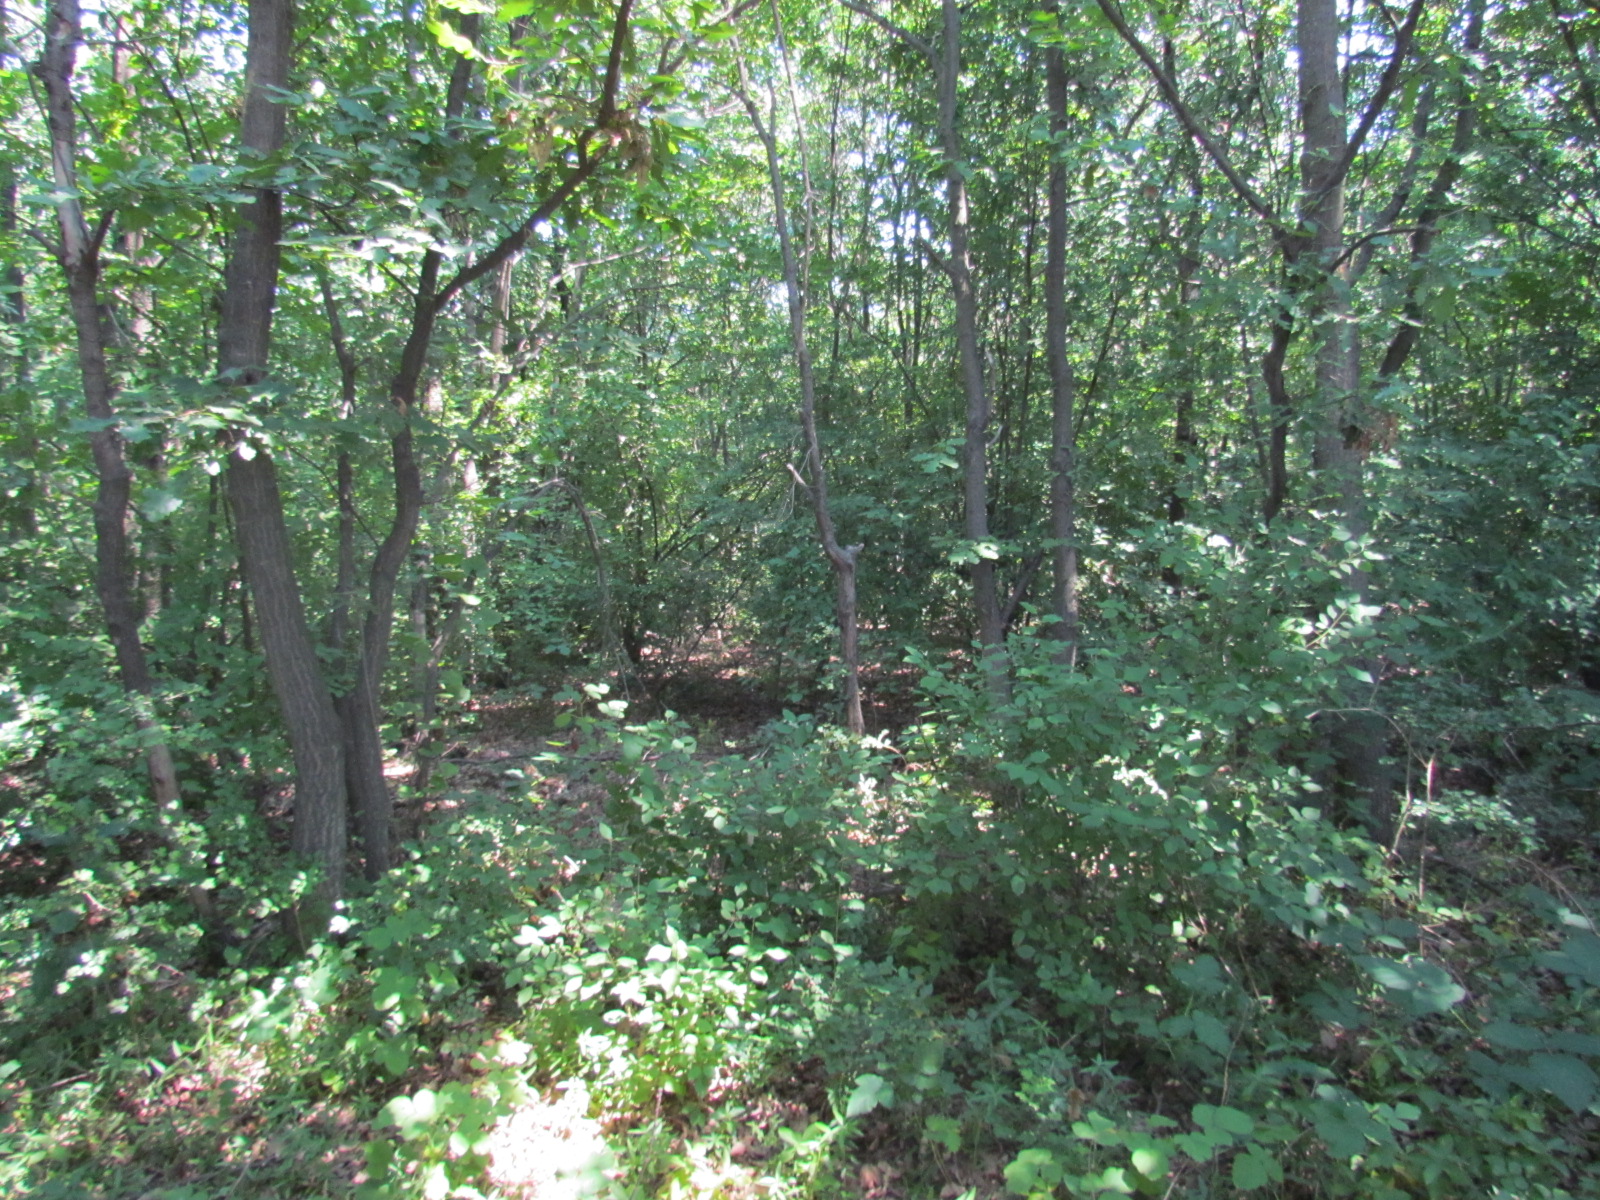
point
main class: Woodland
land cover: Broadleaved woodland
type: acidophilous oak and oak-birch forest
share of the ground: > 75 %
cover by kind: broadleaved forest trees 95 %, shrubs 5 %
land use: Forestry
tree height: > 5 m
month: July
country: BG
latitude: 42.7797
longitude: 27.8929
